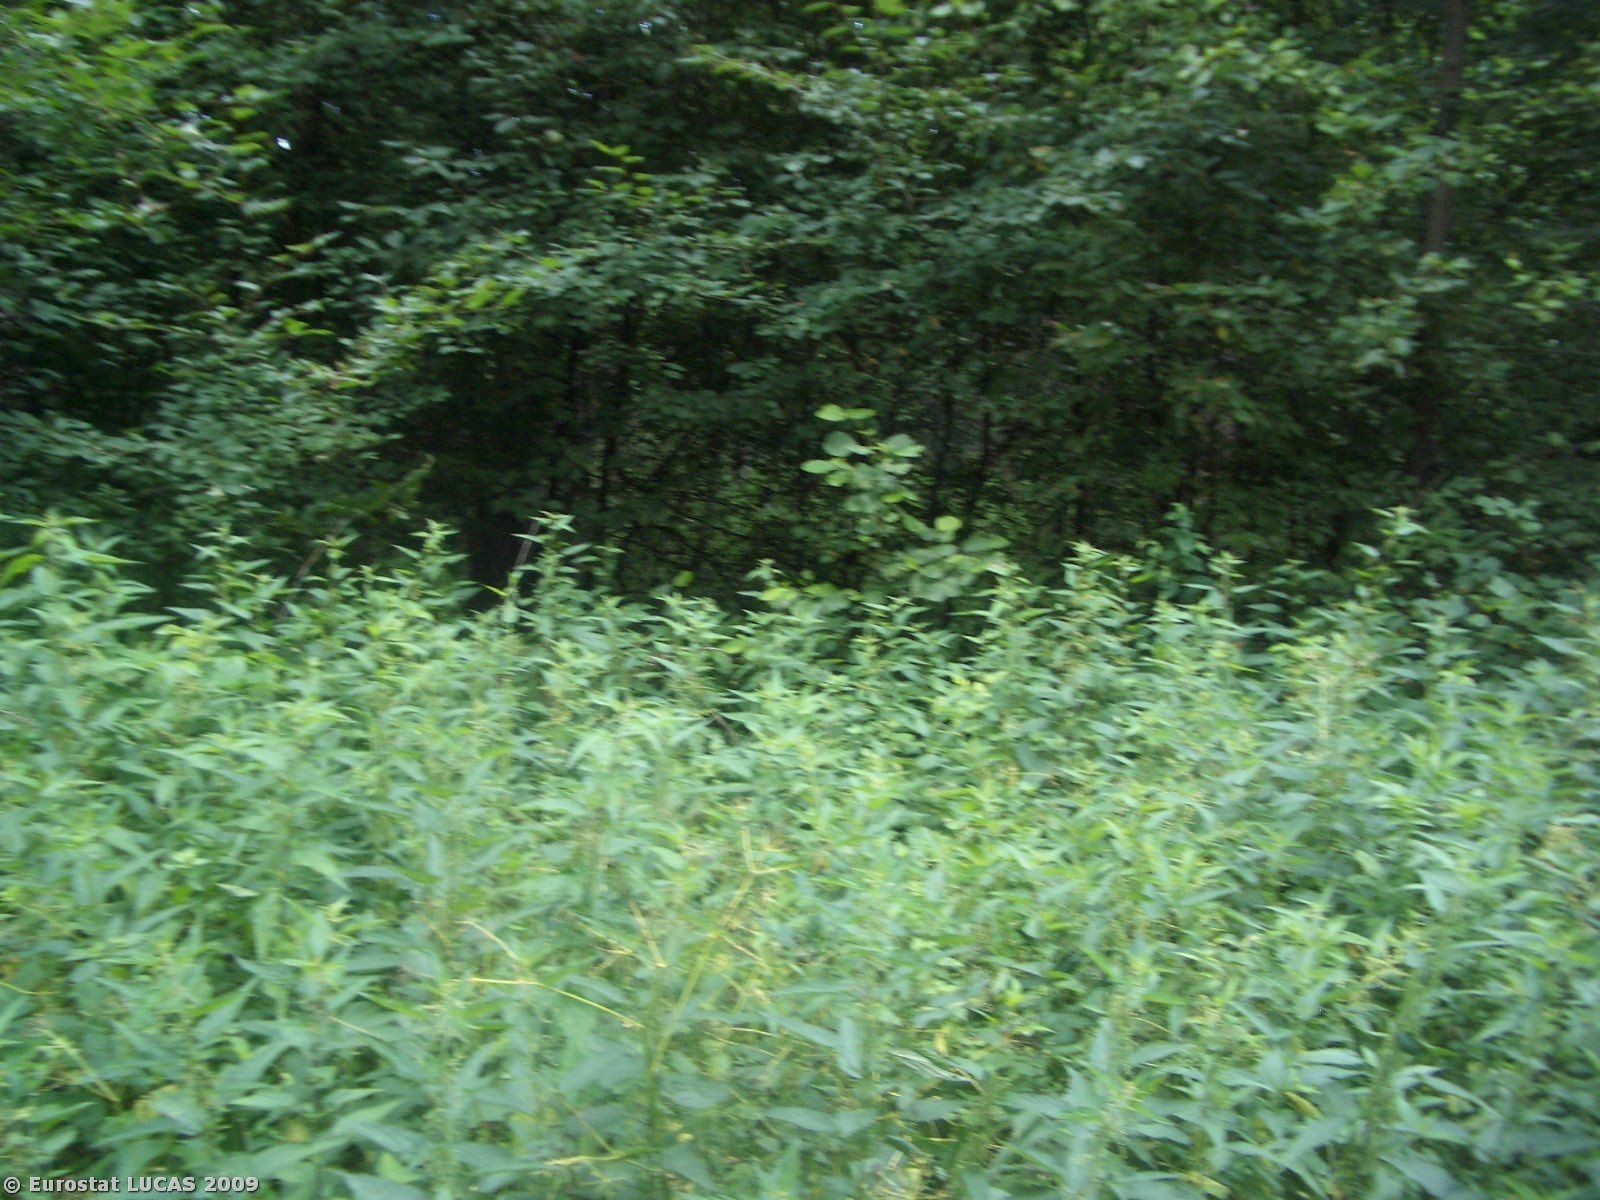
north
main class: Woodland
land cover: Mixed woodland
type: hemiboreal forest and nemoral coniferous forest and mixed broadleaved-coniferous forest
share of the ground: > 75 %
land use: Forestry
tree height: > 5 m
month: July
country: PL
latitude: 52.2699
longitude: 23.0748
